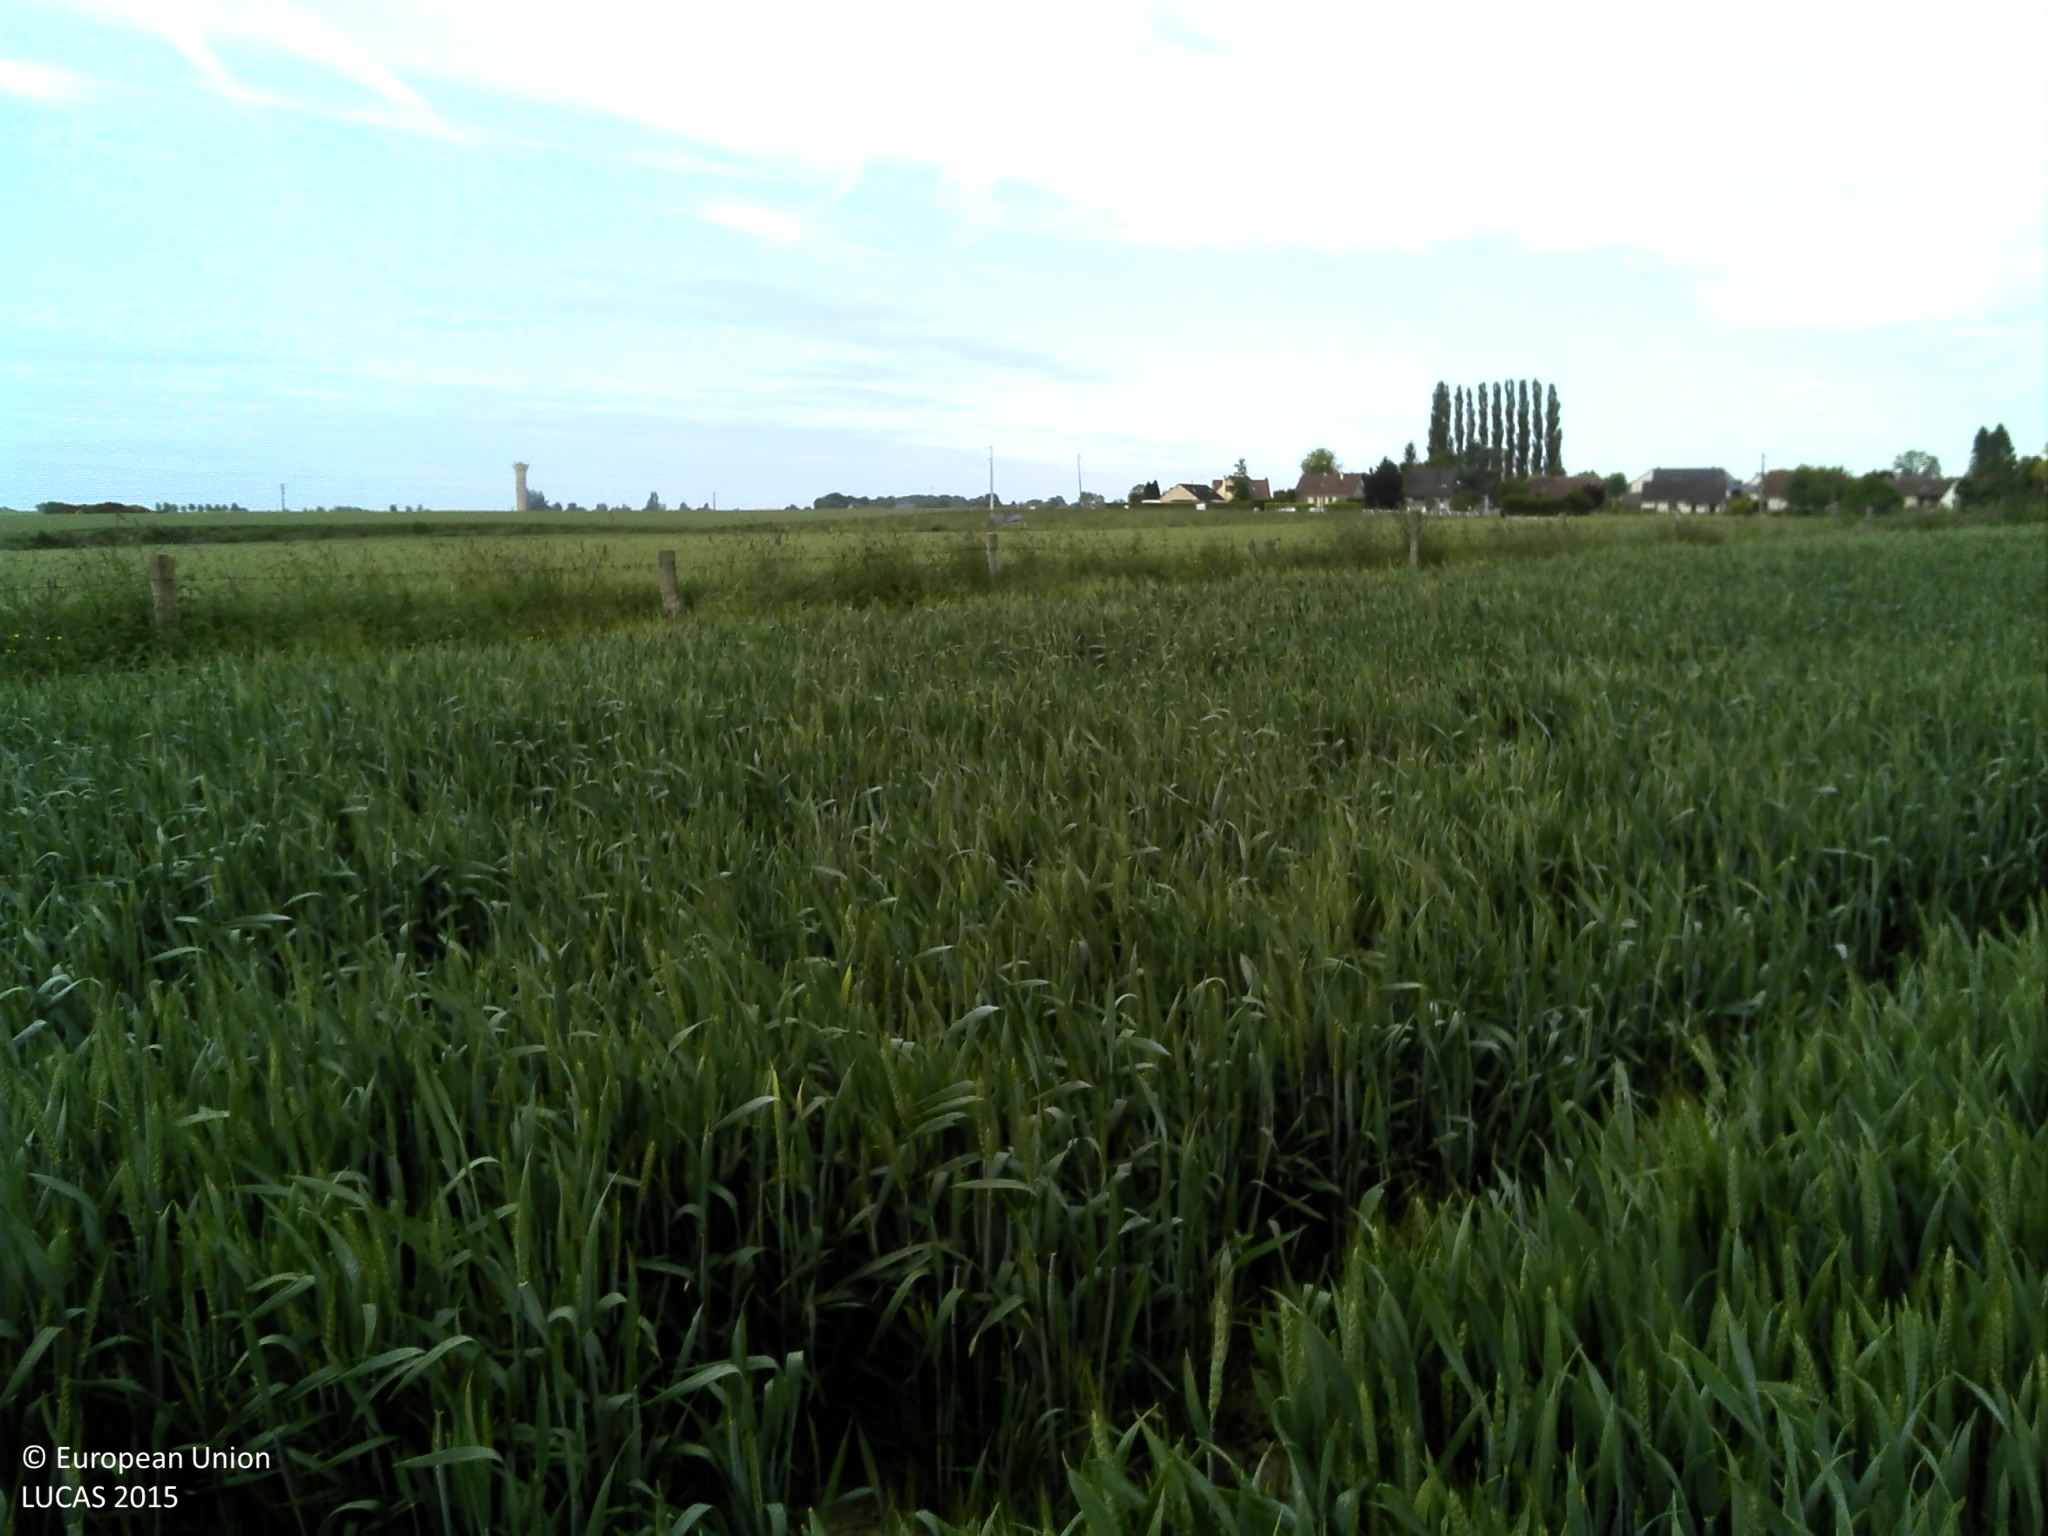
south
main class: Cropland
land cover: Durum wheat
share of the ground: > 75 %
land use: Agriculture (excluding fallow land and kitchen gardens)
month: May
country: FR
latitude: 49.3936
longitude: 1.2306
